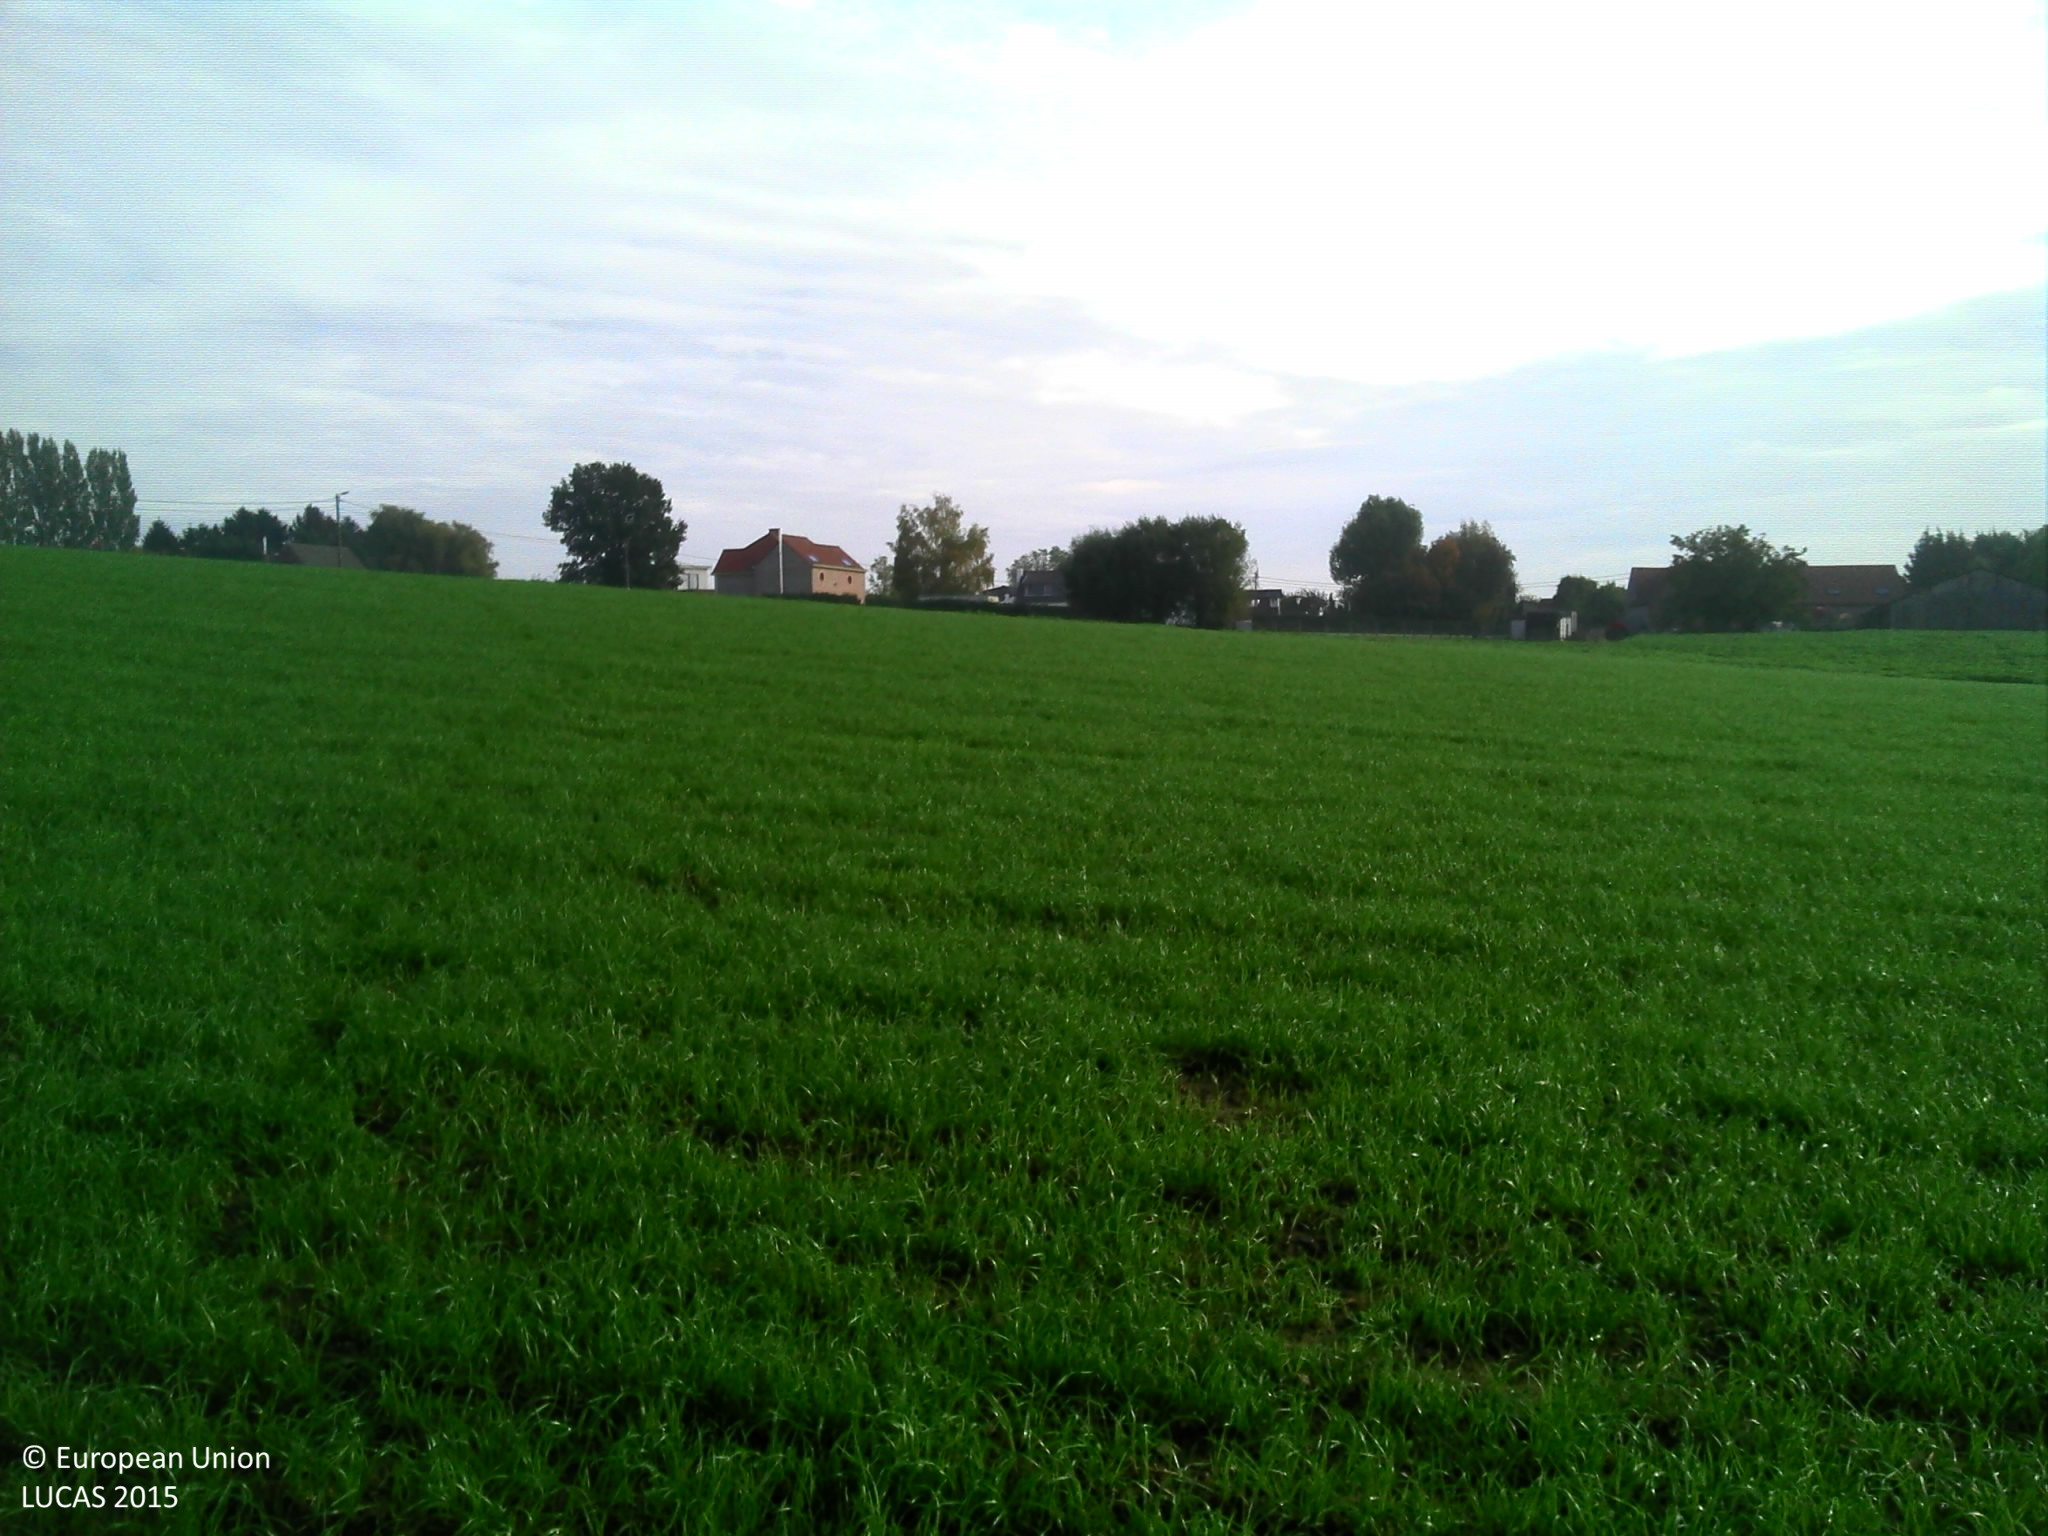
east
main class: Cropland
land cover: Temporary grasslands
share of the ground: > 75 %
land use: Agriculture (excluding fallow land and kitchen gardens)
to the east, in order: Temporary grasslands; Other fibre and oleaginous crops; Fences; Grassland without tree/shrub cover; Fences; Grassland without tree/shrub cover; Fences; Grassland without tree/shrub cover; Artificial constructions in urban areas
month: October
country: BE
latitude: 50.6922
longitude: 3.9778
